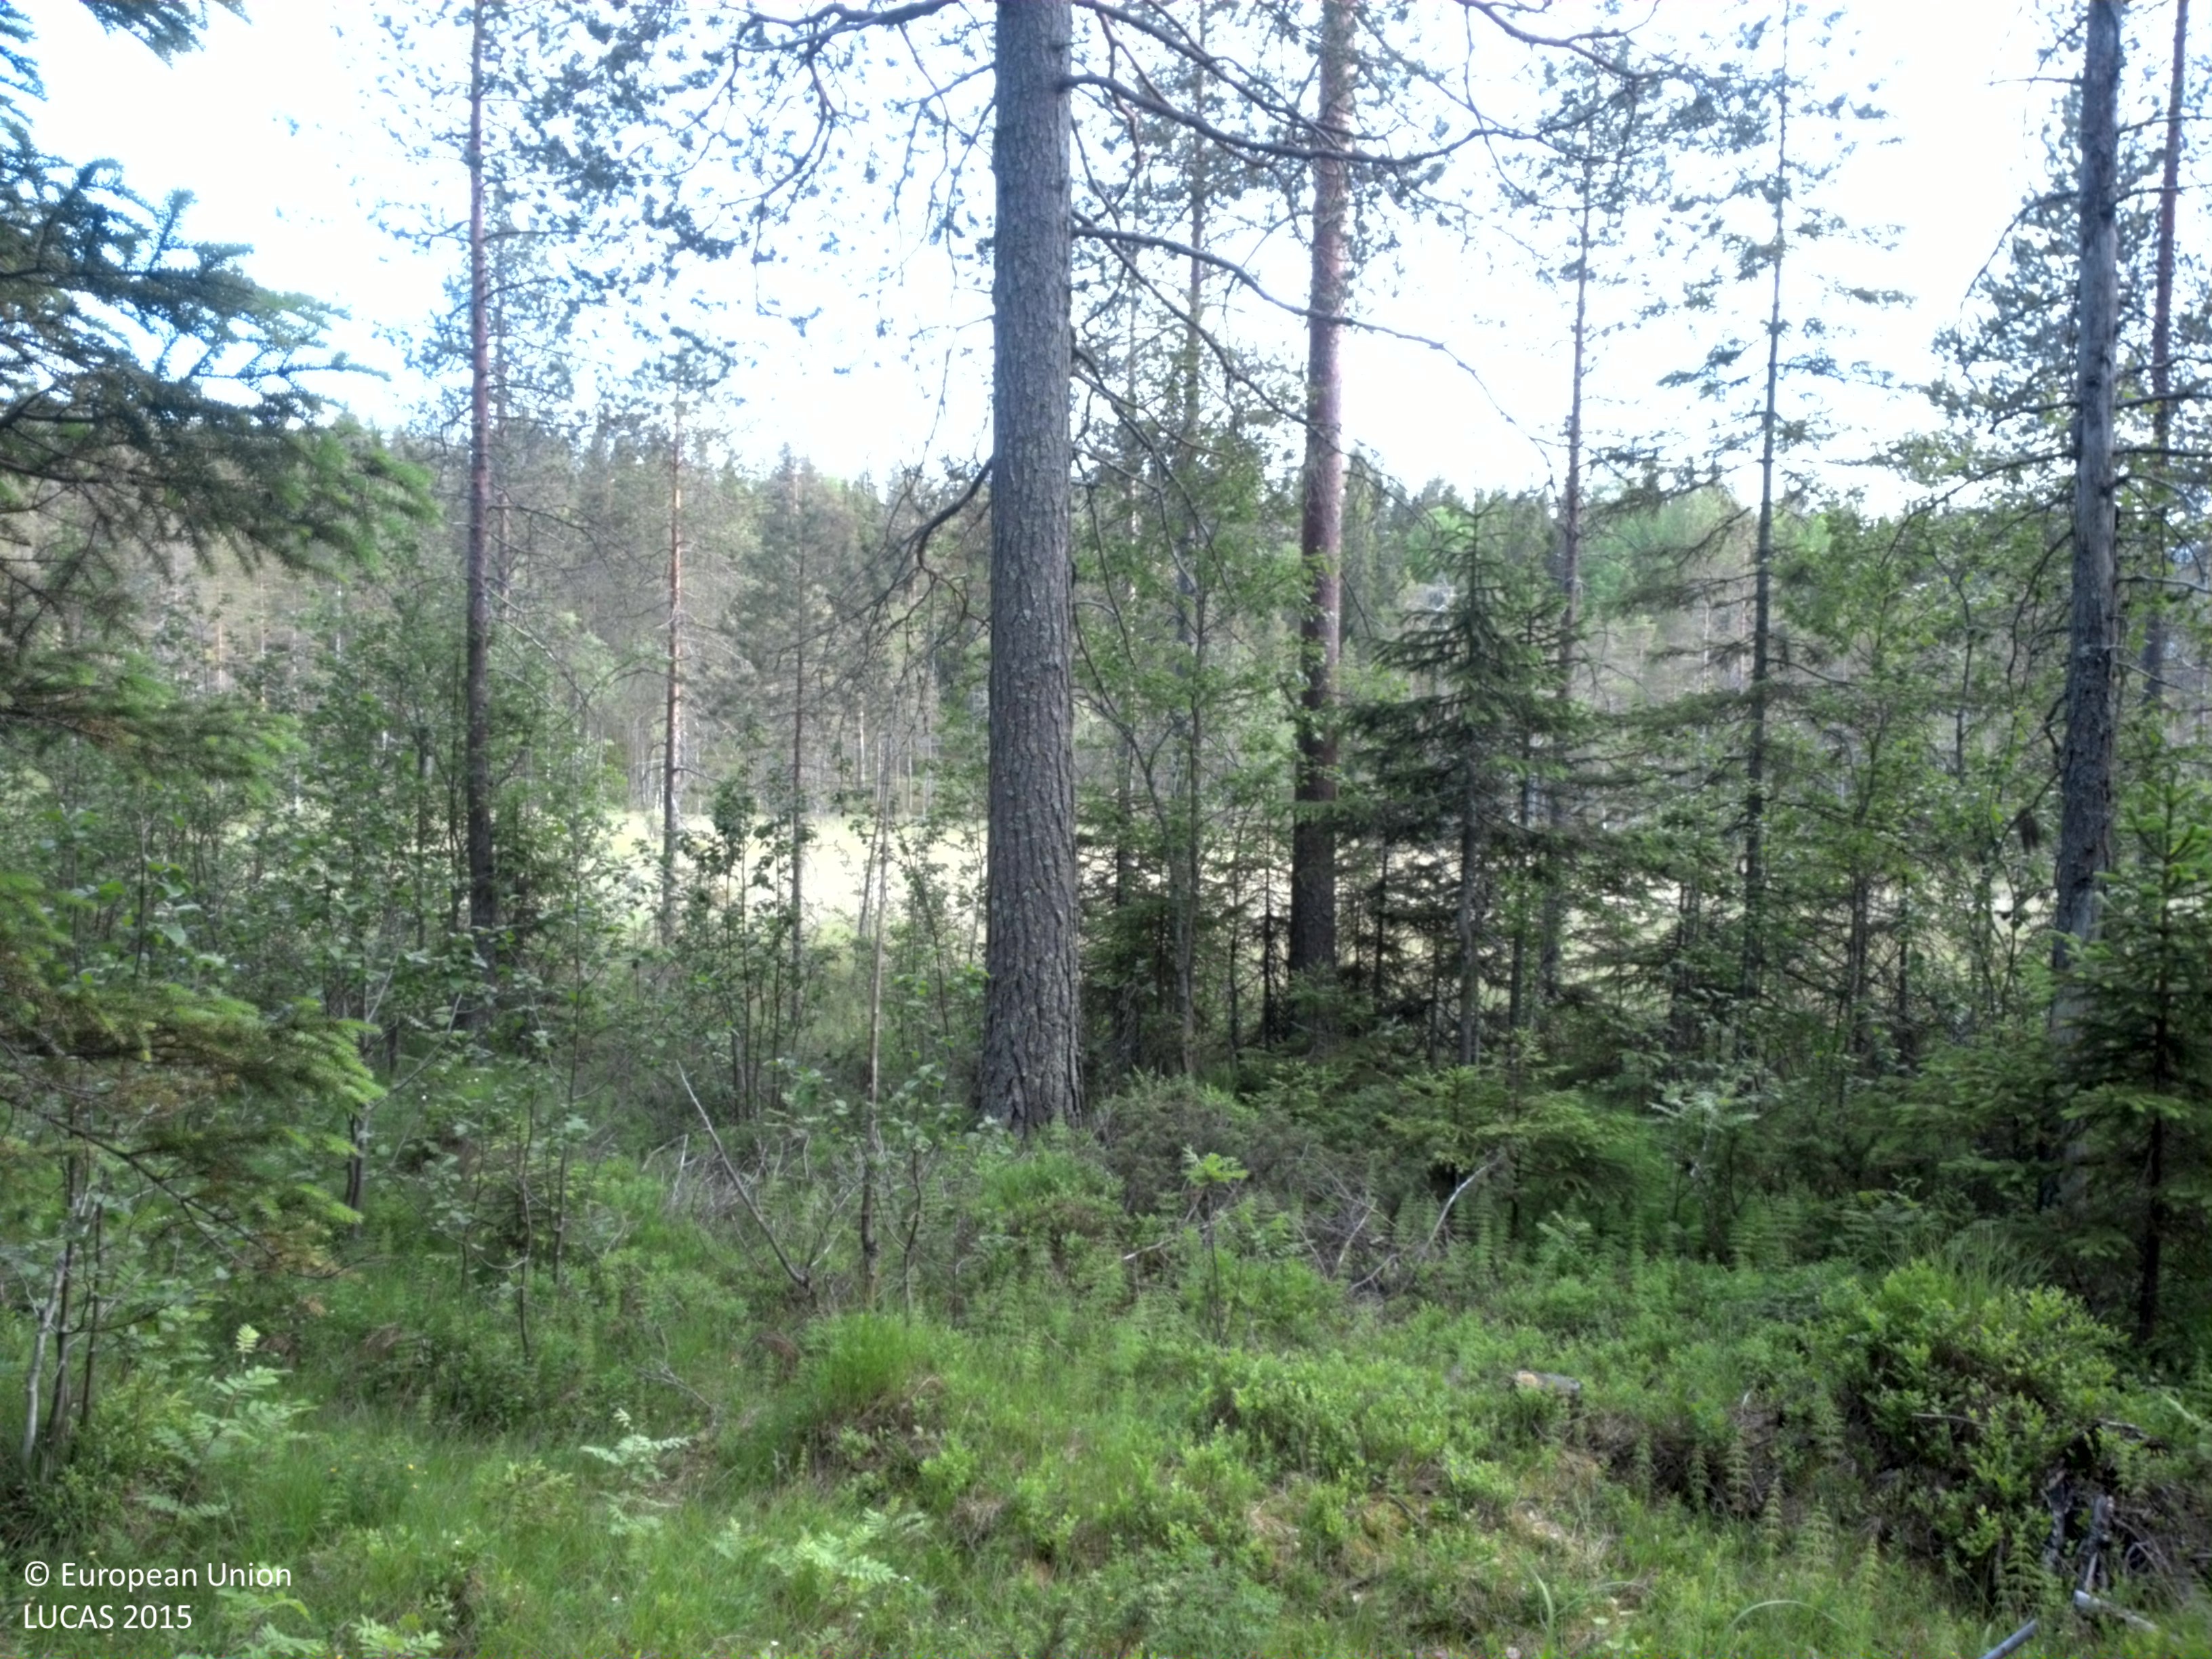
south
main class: Woodland
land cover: Other coniferous woodland
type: boreal forest
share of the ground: 25 - 50 %
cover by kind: coniferous forest trees 50 %, shrubs 30 %
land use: Forestry
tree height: > 5 m
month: July
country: SE
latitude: 64.3266
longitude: 20.7172
